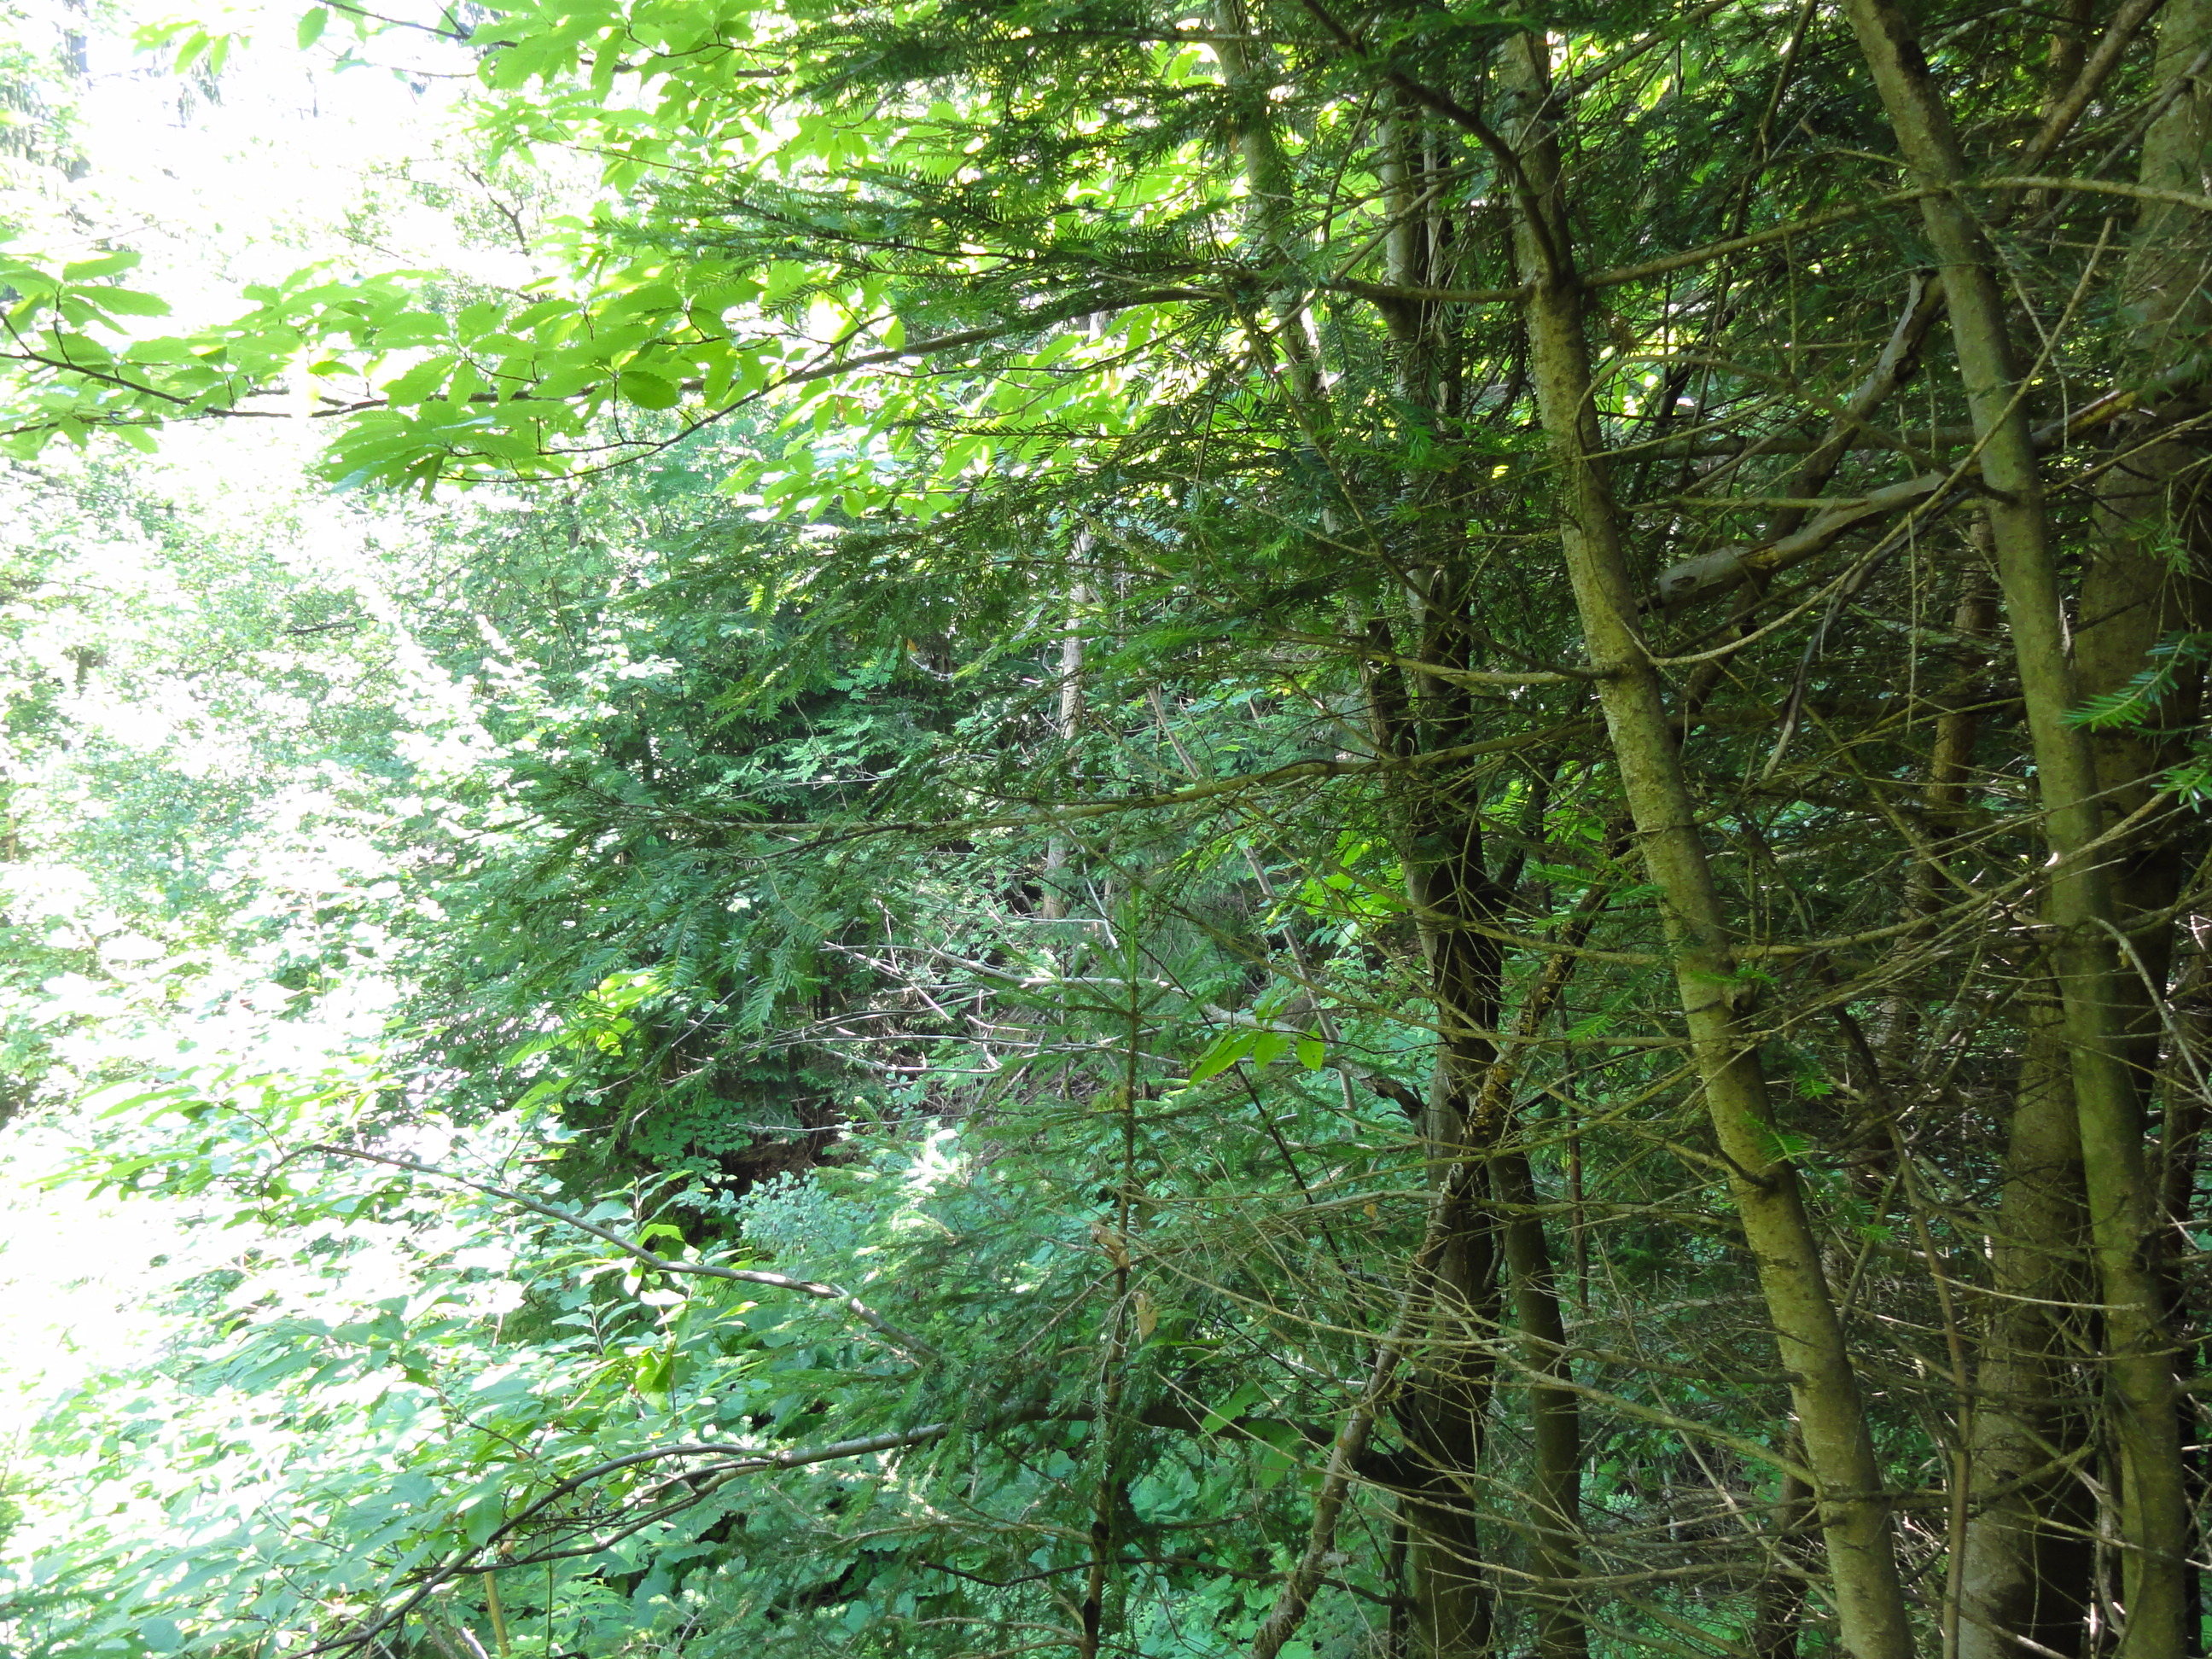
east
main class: Woodland
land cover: Spruce dominated mixed woodland
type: hemiboreal forest and nemoral coniferous forest and mixed broadleaved-coniferous forest
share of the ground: > 75 %
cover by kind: broadleaved forest trees 50 %, coniferous forest trees 40 %, shrubs 5 %, unconsolidated bare surface 5 %
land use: Forestry
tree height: > 5 m
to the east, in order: Spruce dominated mixed woodland; Rivers and streams; Spruce dominated mixed woodland; Spruce dominated coniferous woodland; Rivers and streams; Spruce dominated mixed woodland; Rivers and streams; Spruce dominated mixed woodland; Rivers and streams; Spruce dominated mixed woodland; Rivers and streams; Spruce dominated mixed woodland; Spruce dominated coniferous woodland; Spruce dominated mixed woodland; Tracks; Spruce dominated mixed woodland
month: June
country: SI
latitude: 46.1964
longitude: 15.0381
